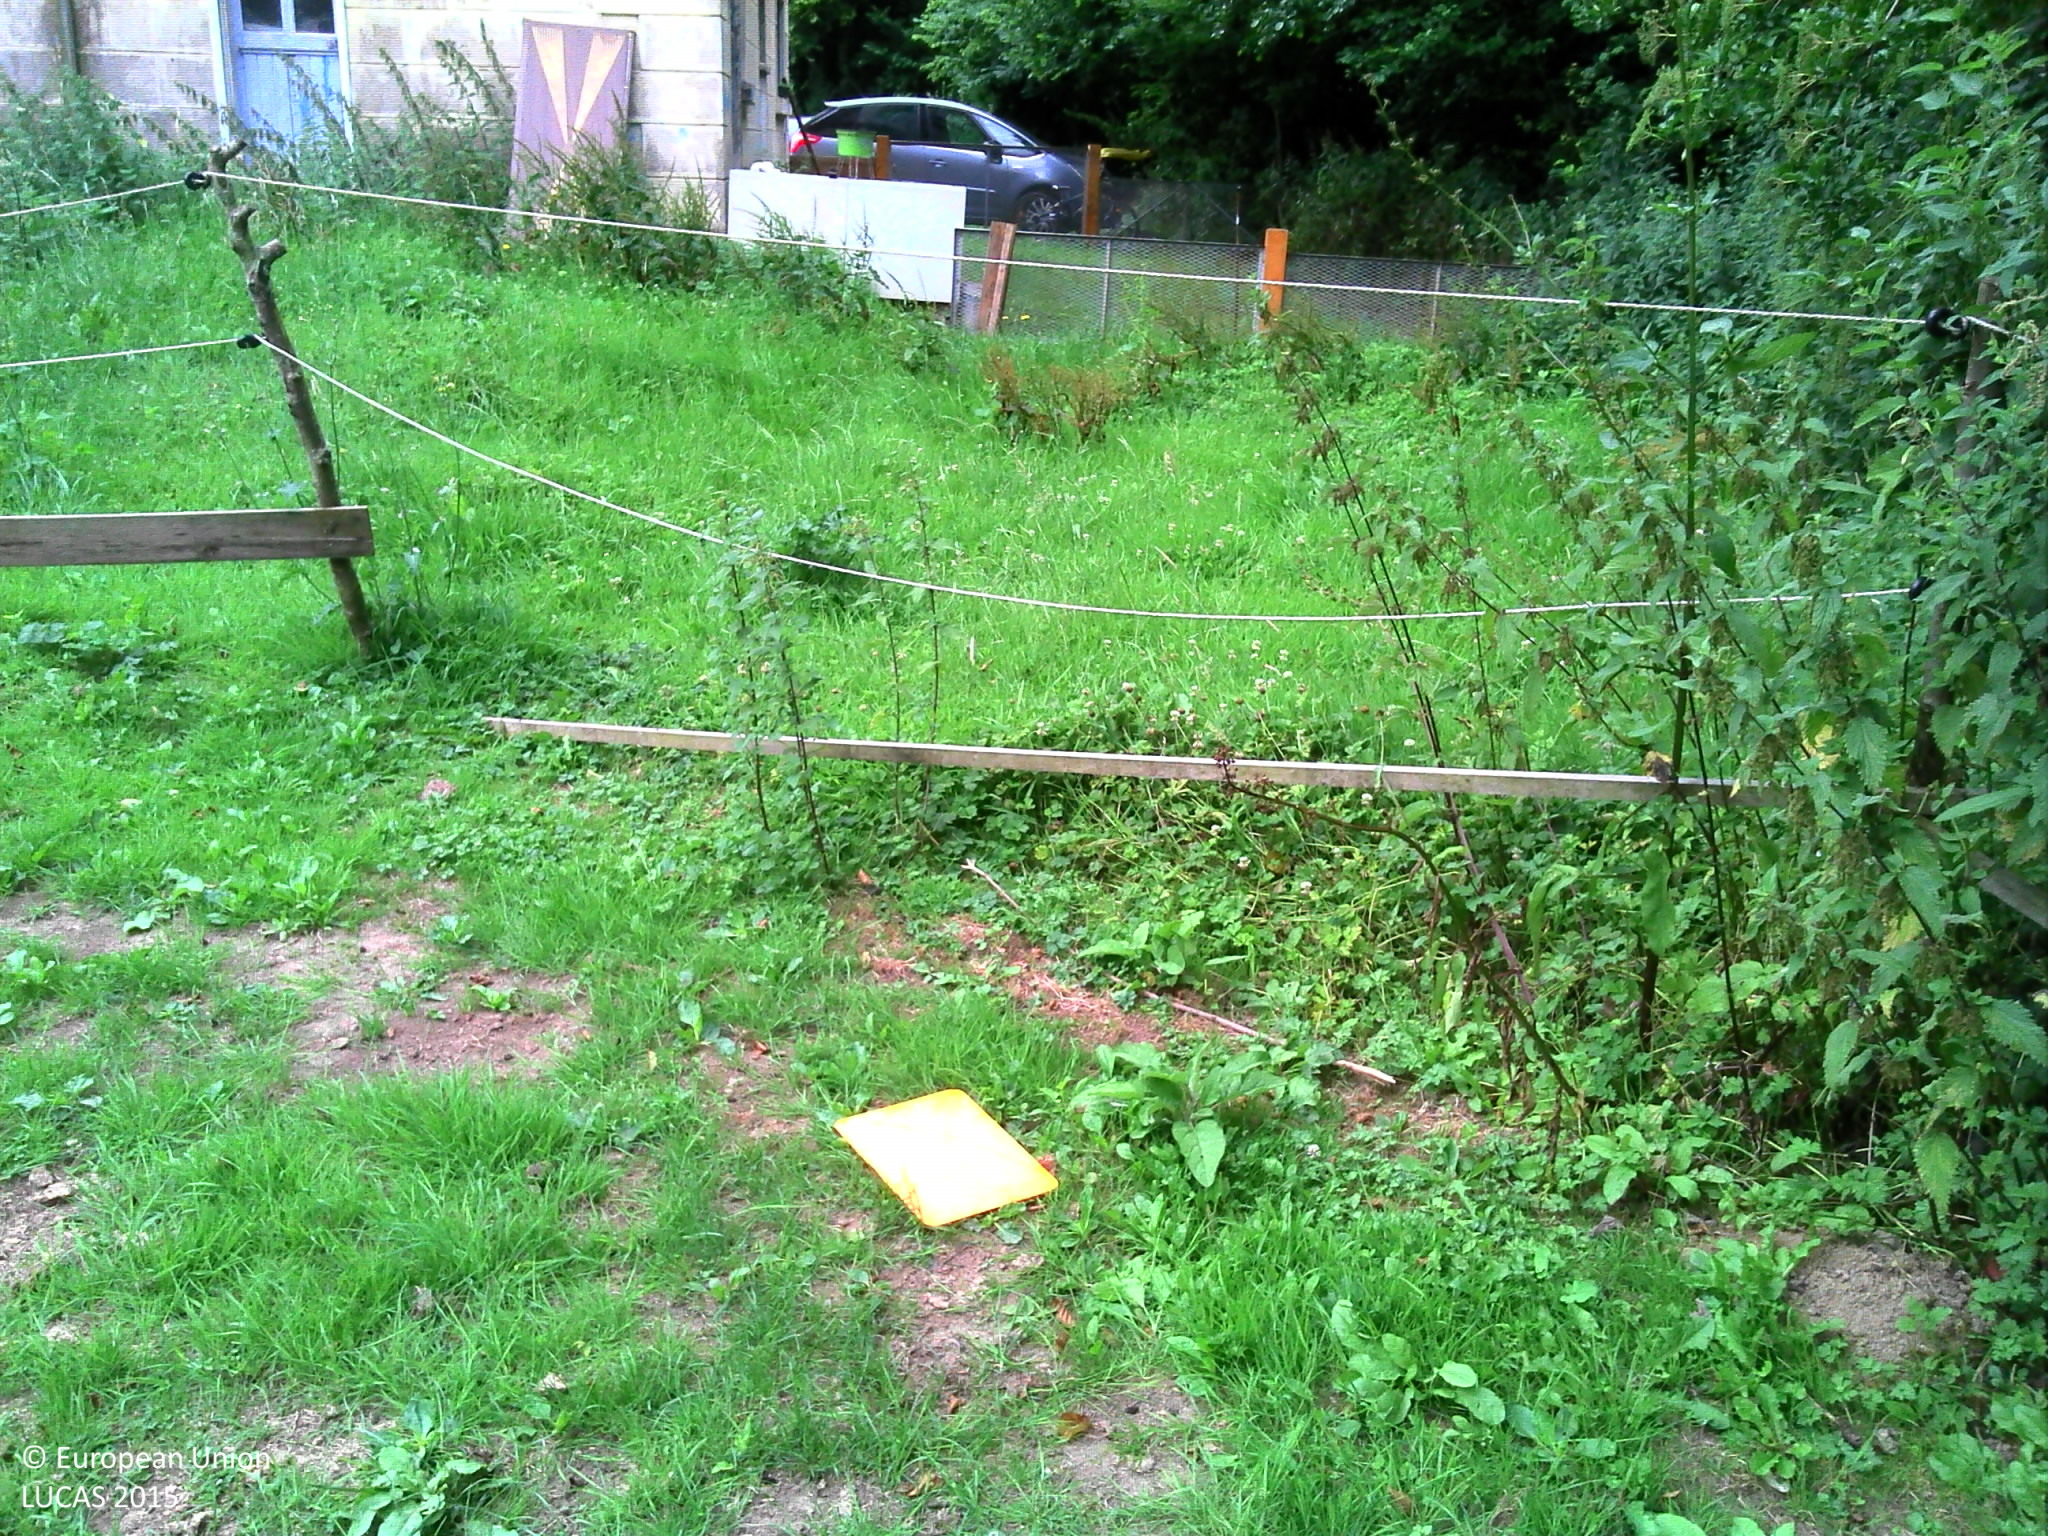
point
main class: Grassland
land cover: Grassland without tree/shrub cover
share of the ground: > 75 %
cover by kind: herbaceous plants 100 %
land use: Residential
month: July
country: FR
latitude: 49.0270
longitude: -0.3048
